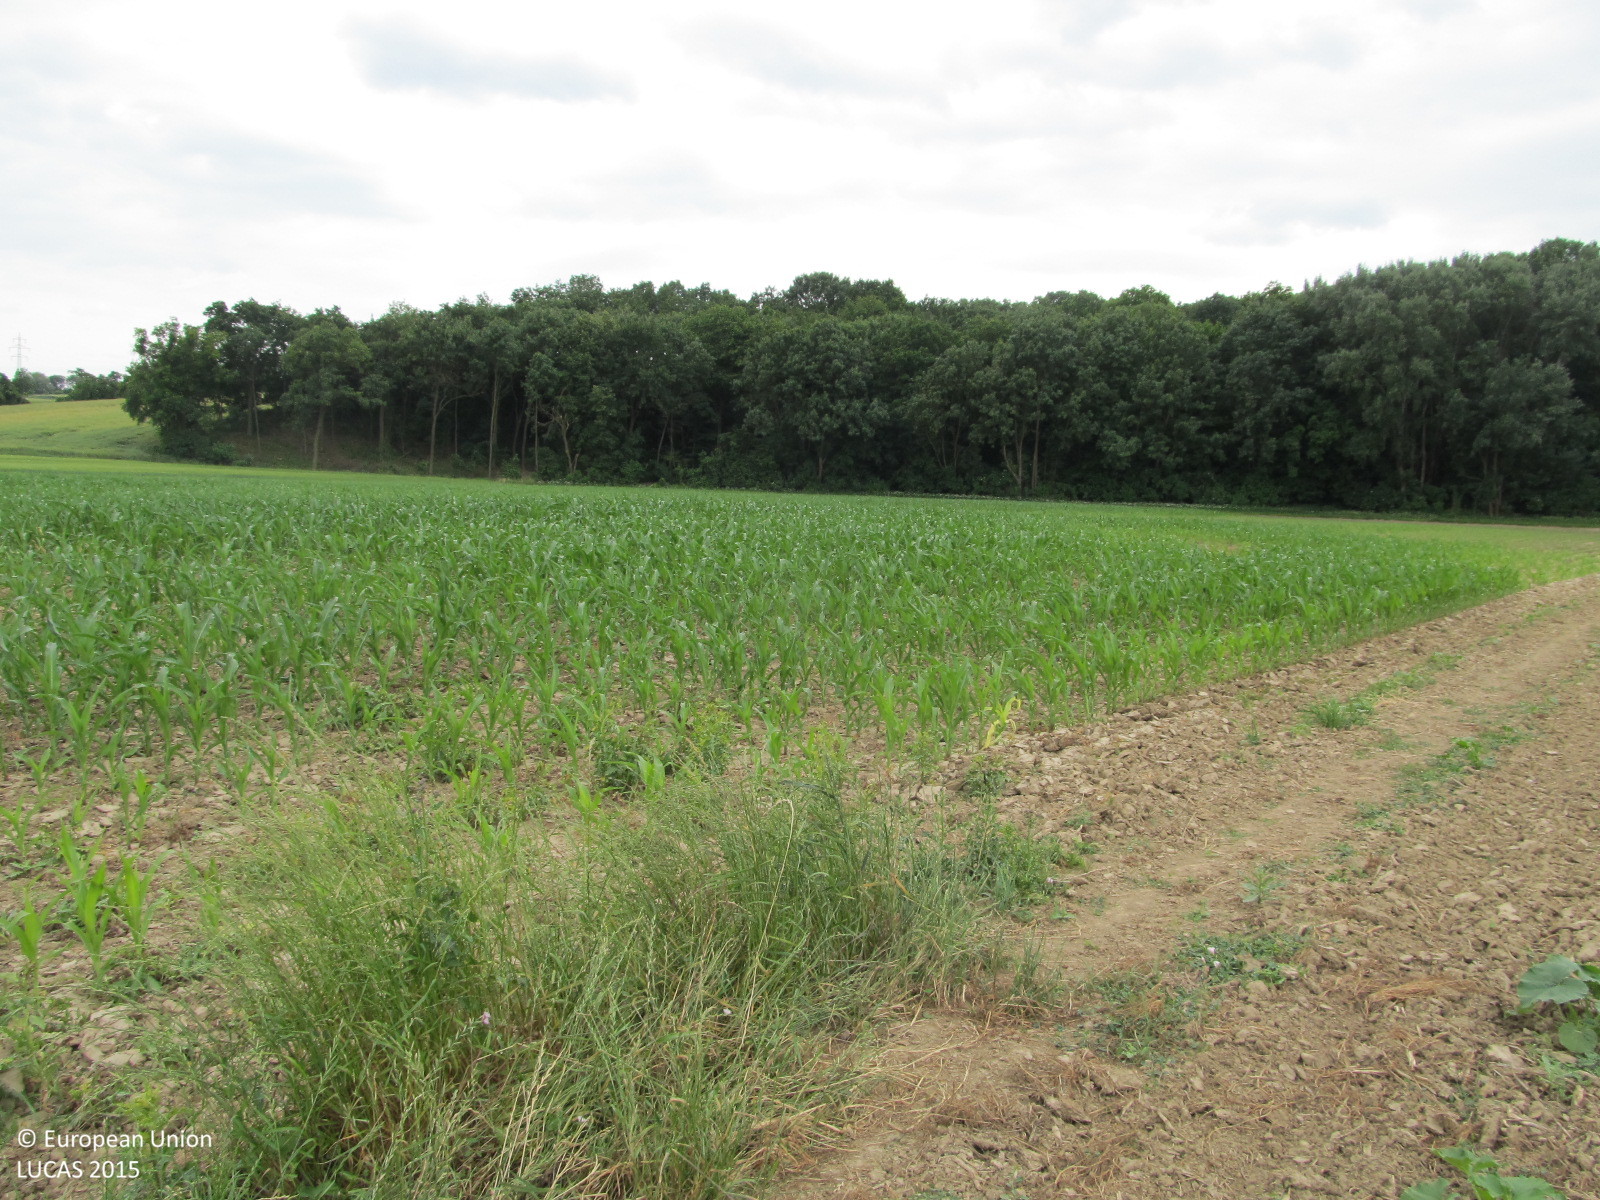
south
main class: Cropland
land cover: Other fibre and oleaginous crops
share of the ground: < 10 %
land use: Agriculture (excluding fallow land and kitchen gardens)
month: June
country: AT
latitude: 48.5067
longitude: 16.0819
